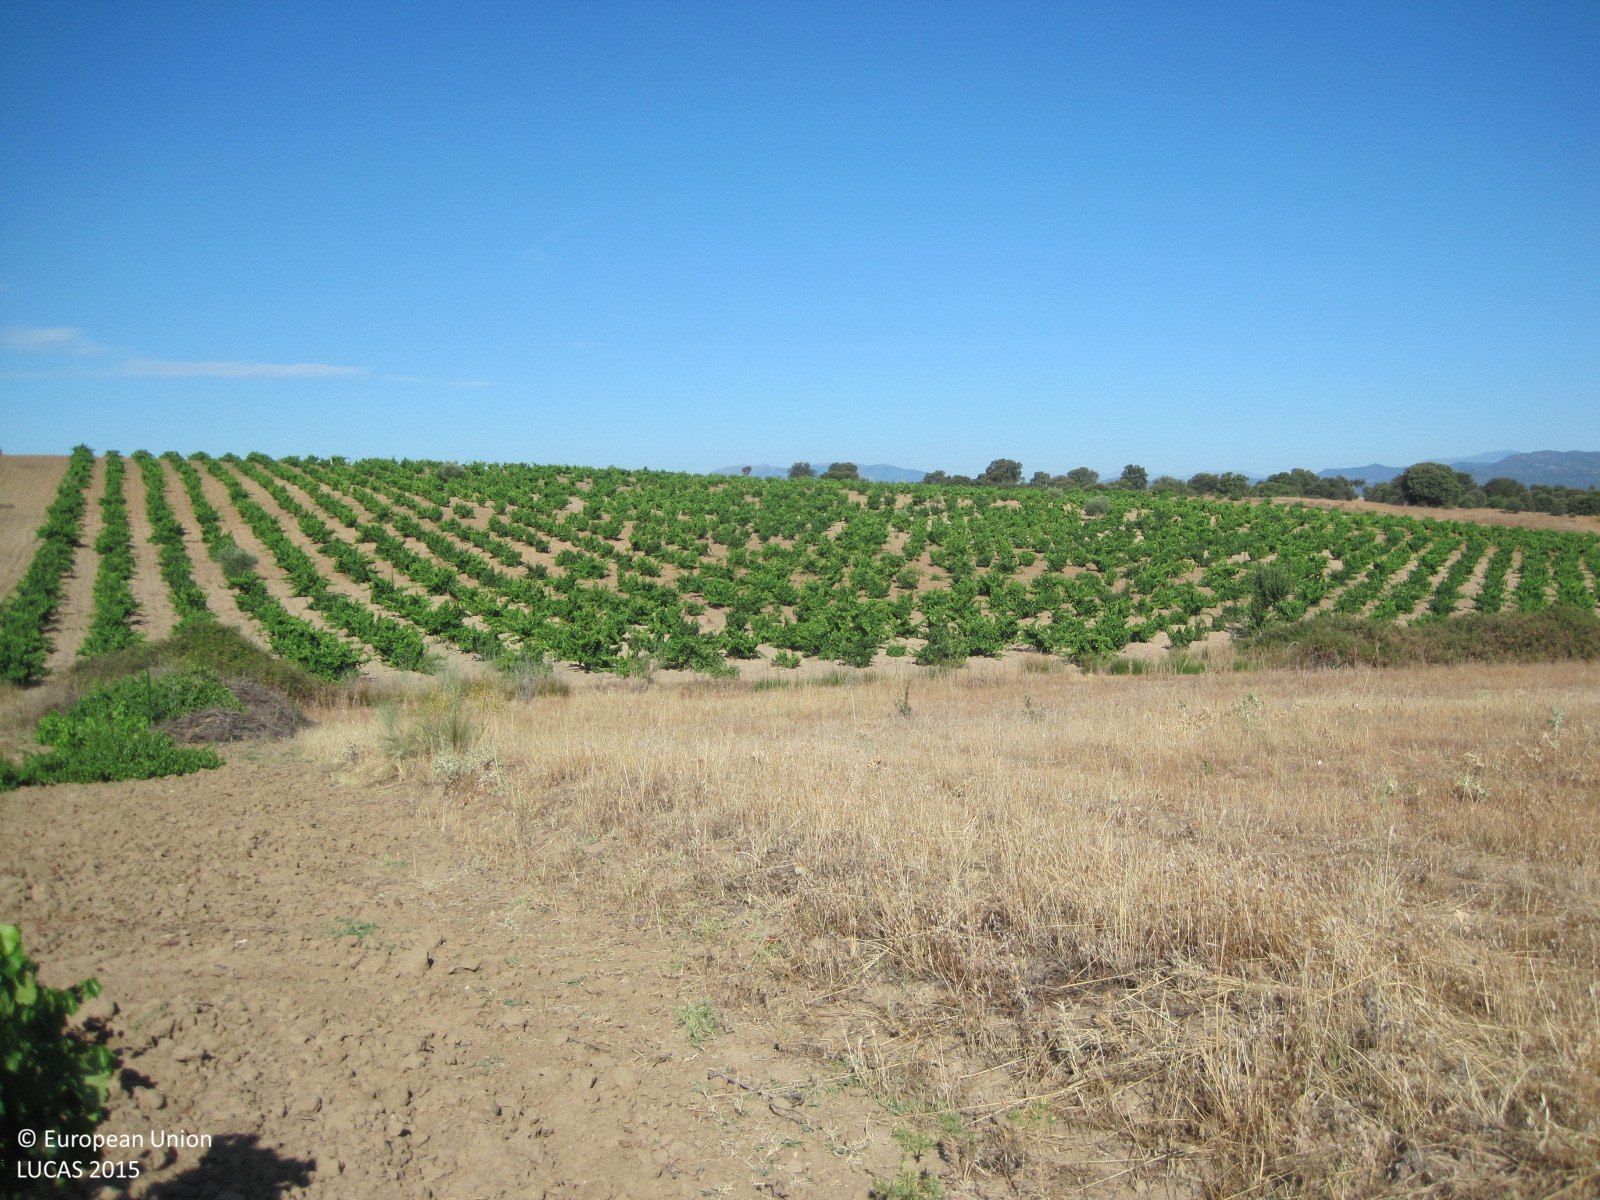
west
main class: Cropland
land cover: Vineyards
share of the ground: 25 - 50 %
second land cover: Other bare soil
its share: > 75 %
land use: Agriculture (excluding fallow land and kitchen gardens)
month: July
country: ES
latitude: 40.1382
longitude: -4.3741
